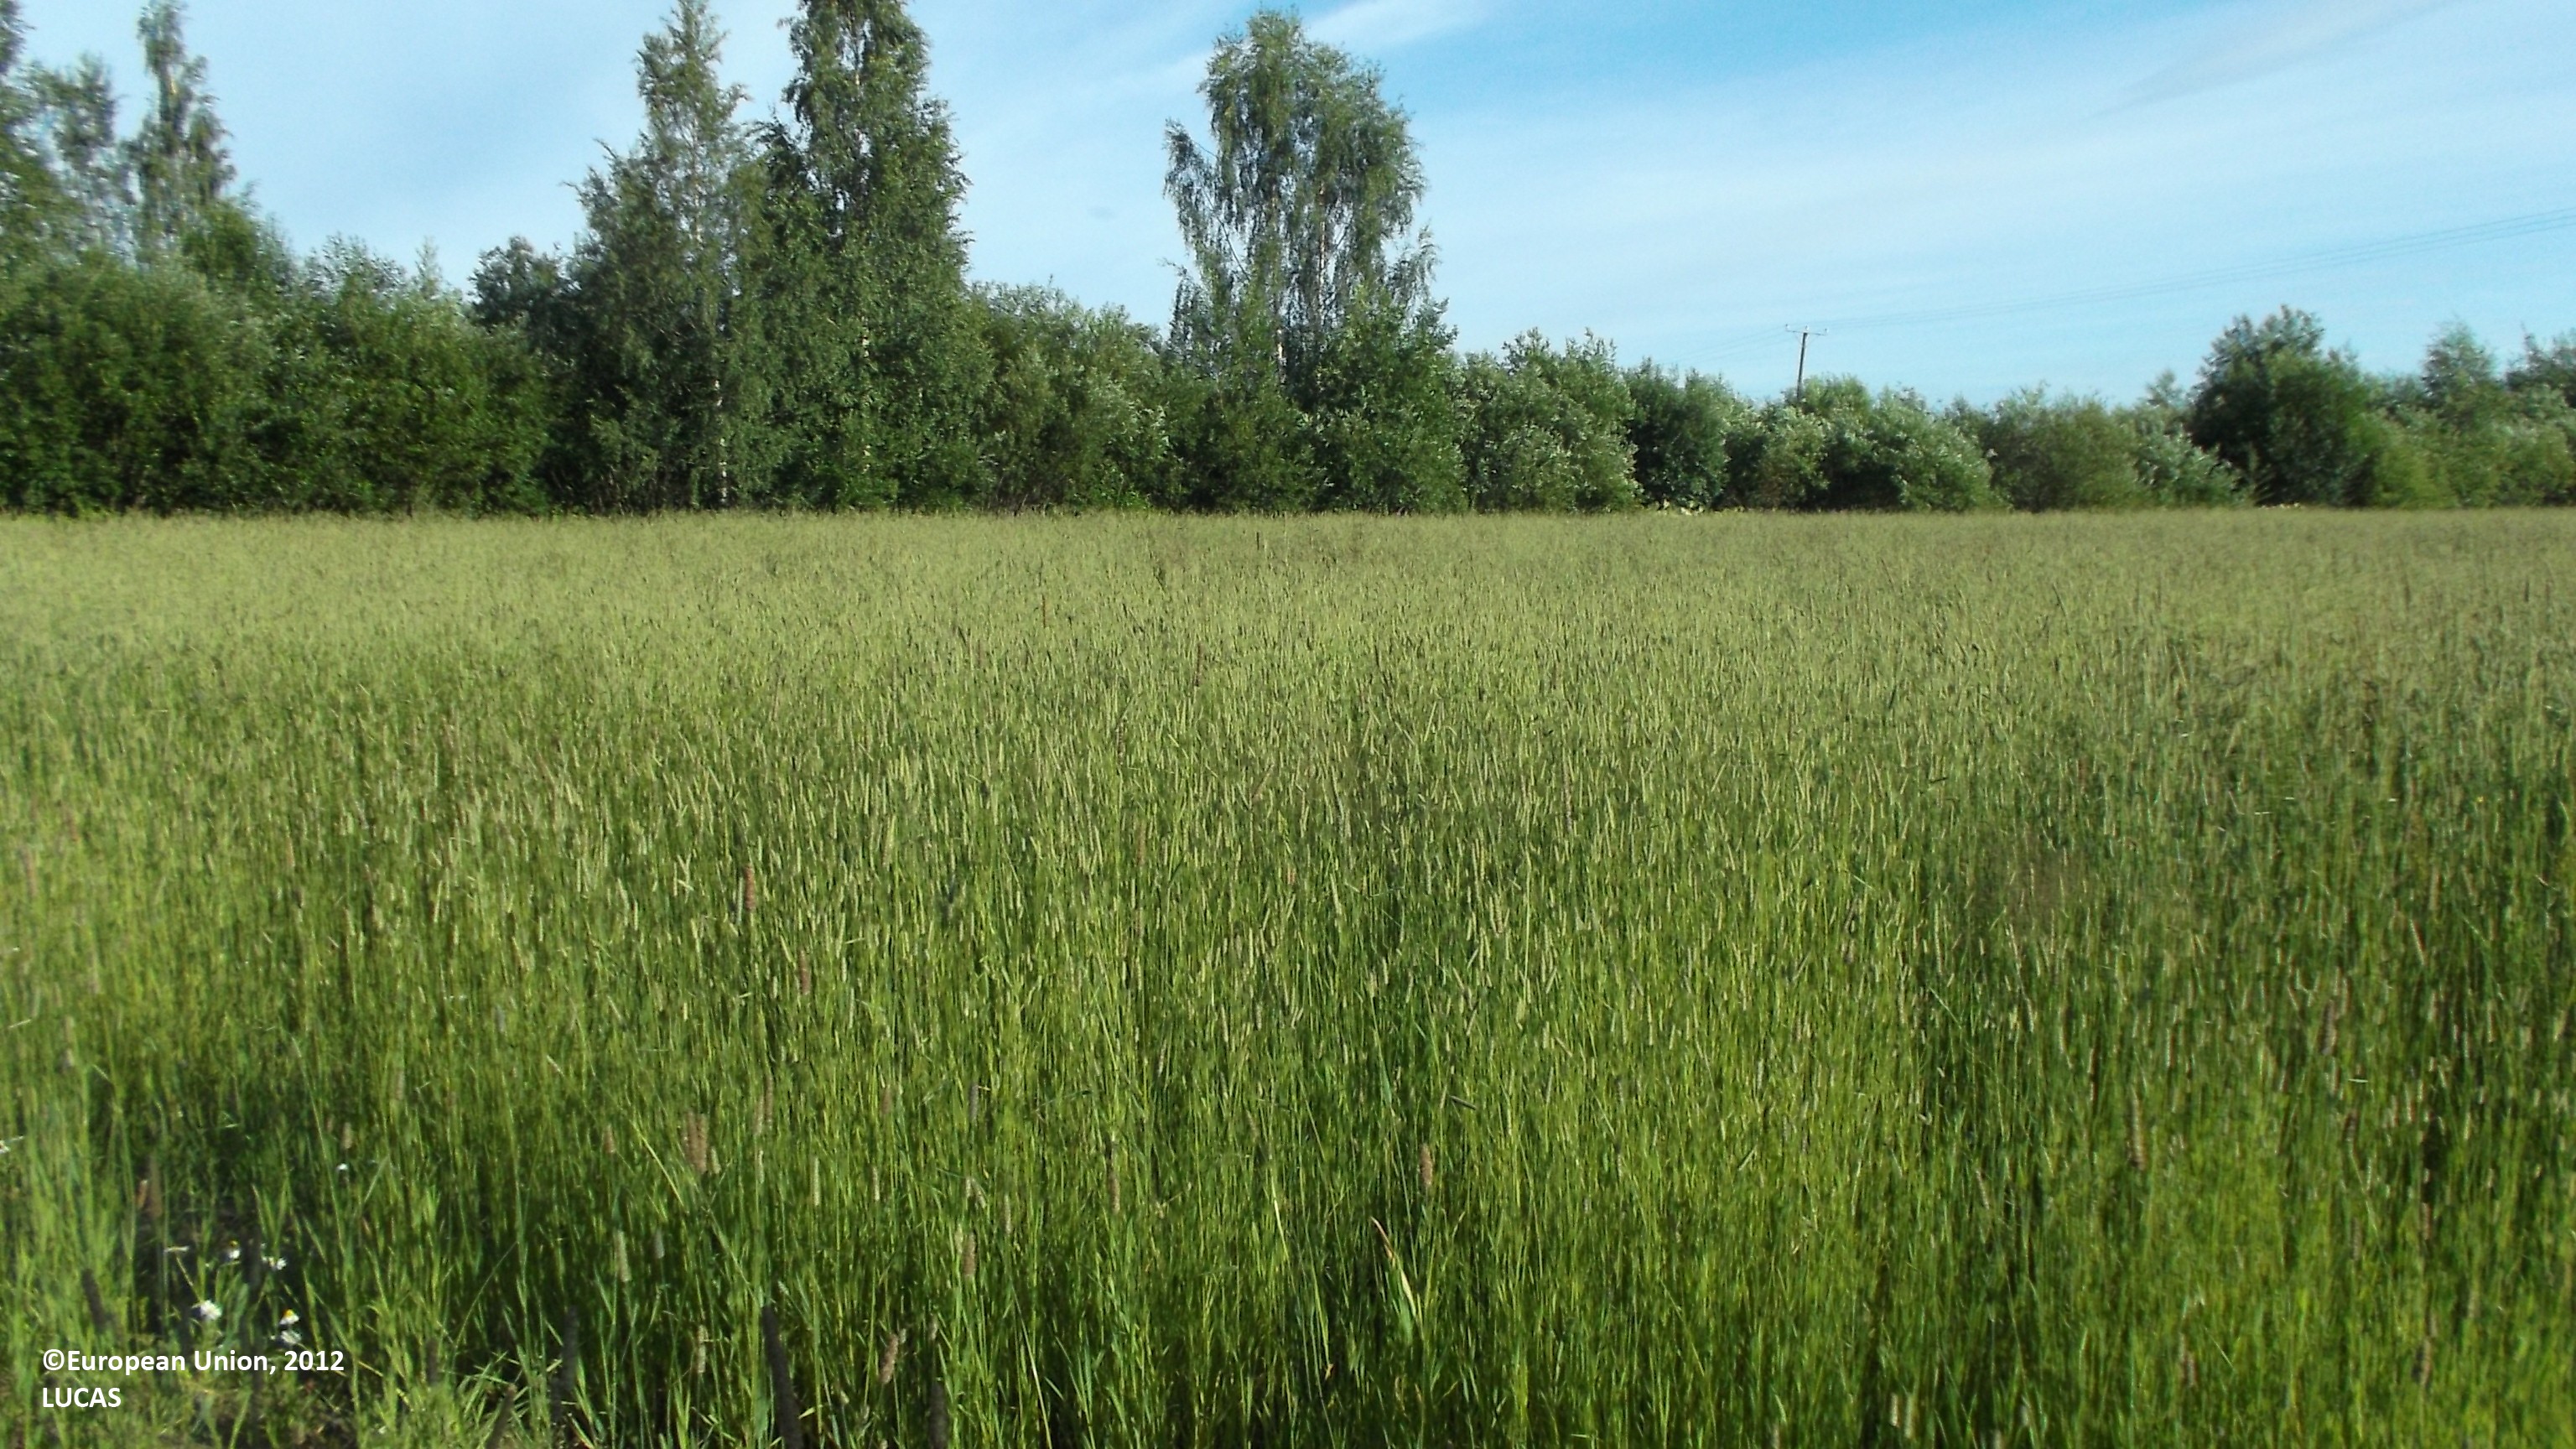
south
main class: Cropland
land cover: Temporary grasslands
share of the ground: 50 - 75 %
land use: Agriculture (excluding fallow land and kitchen gardens)
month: July
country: FI
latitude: 63.2272
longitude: 23.7388
